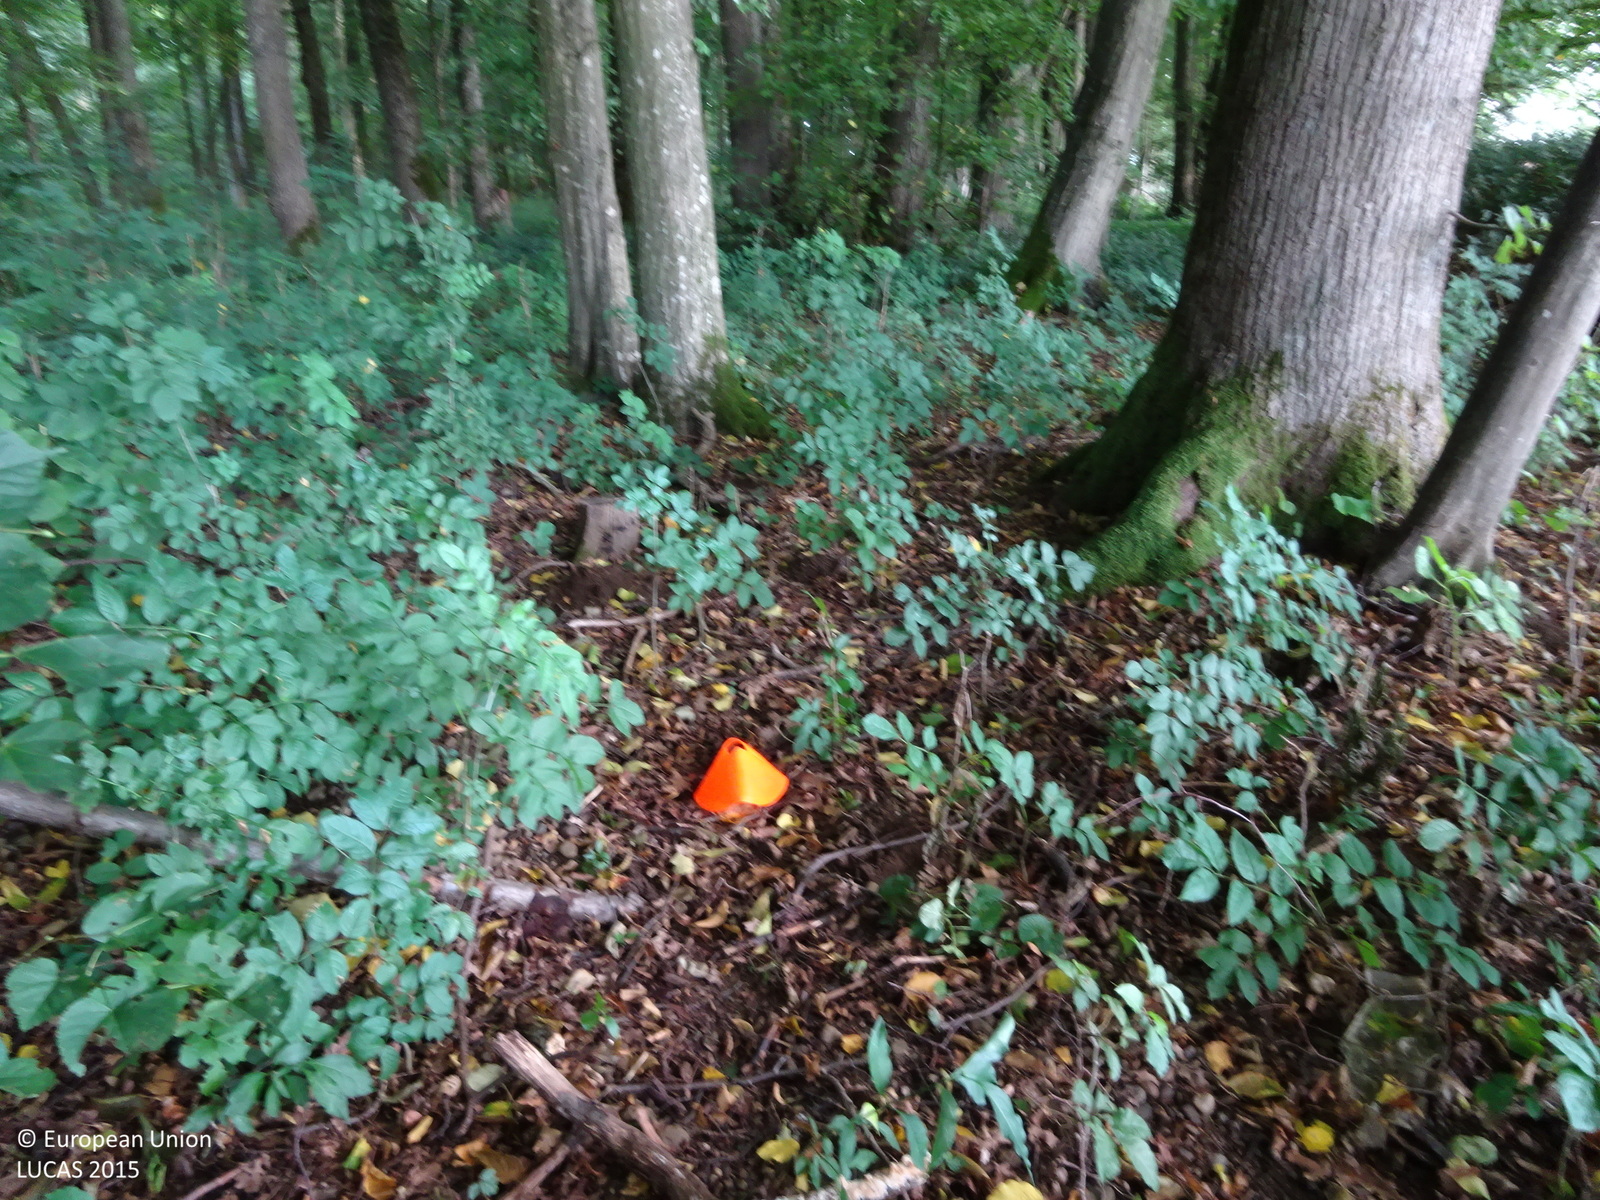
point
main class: Woodland
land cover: Broadleaved woodland
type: hemiboreal forest and nemoral coniferous forest and mixed broadleaved-coniferous forest
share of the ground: > 75 %
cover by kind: broadleaved forest trees 100 %
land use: Forestry
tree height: > 5 m
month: July
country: AT
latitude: 46.9149
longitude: 15.4749
